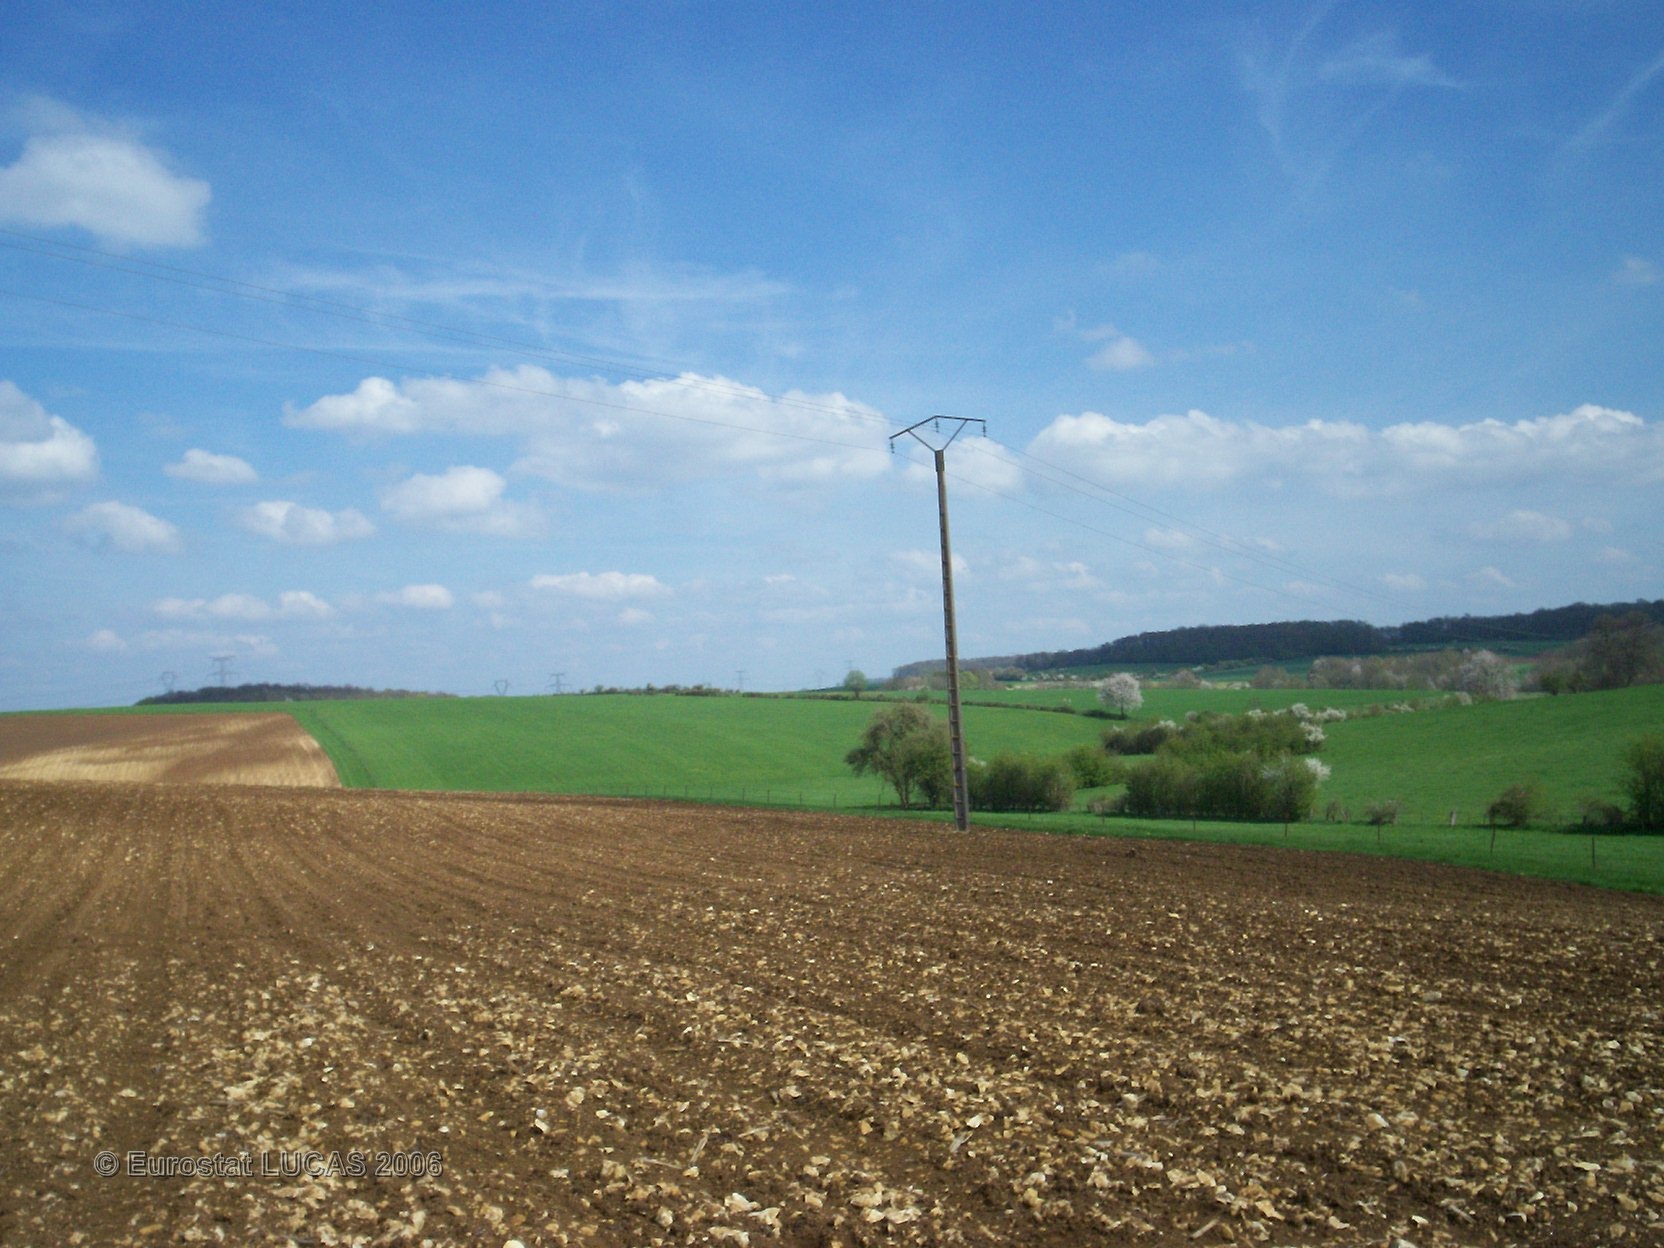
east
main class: Cropland
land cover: Maize
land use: Agriculture (excluding fallow land and kitchen gardens)
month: May
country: FR
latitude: 49.8245
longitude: 4.2824
